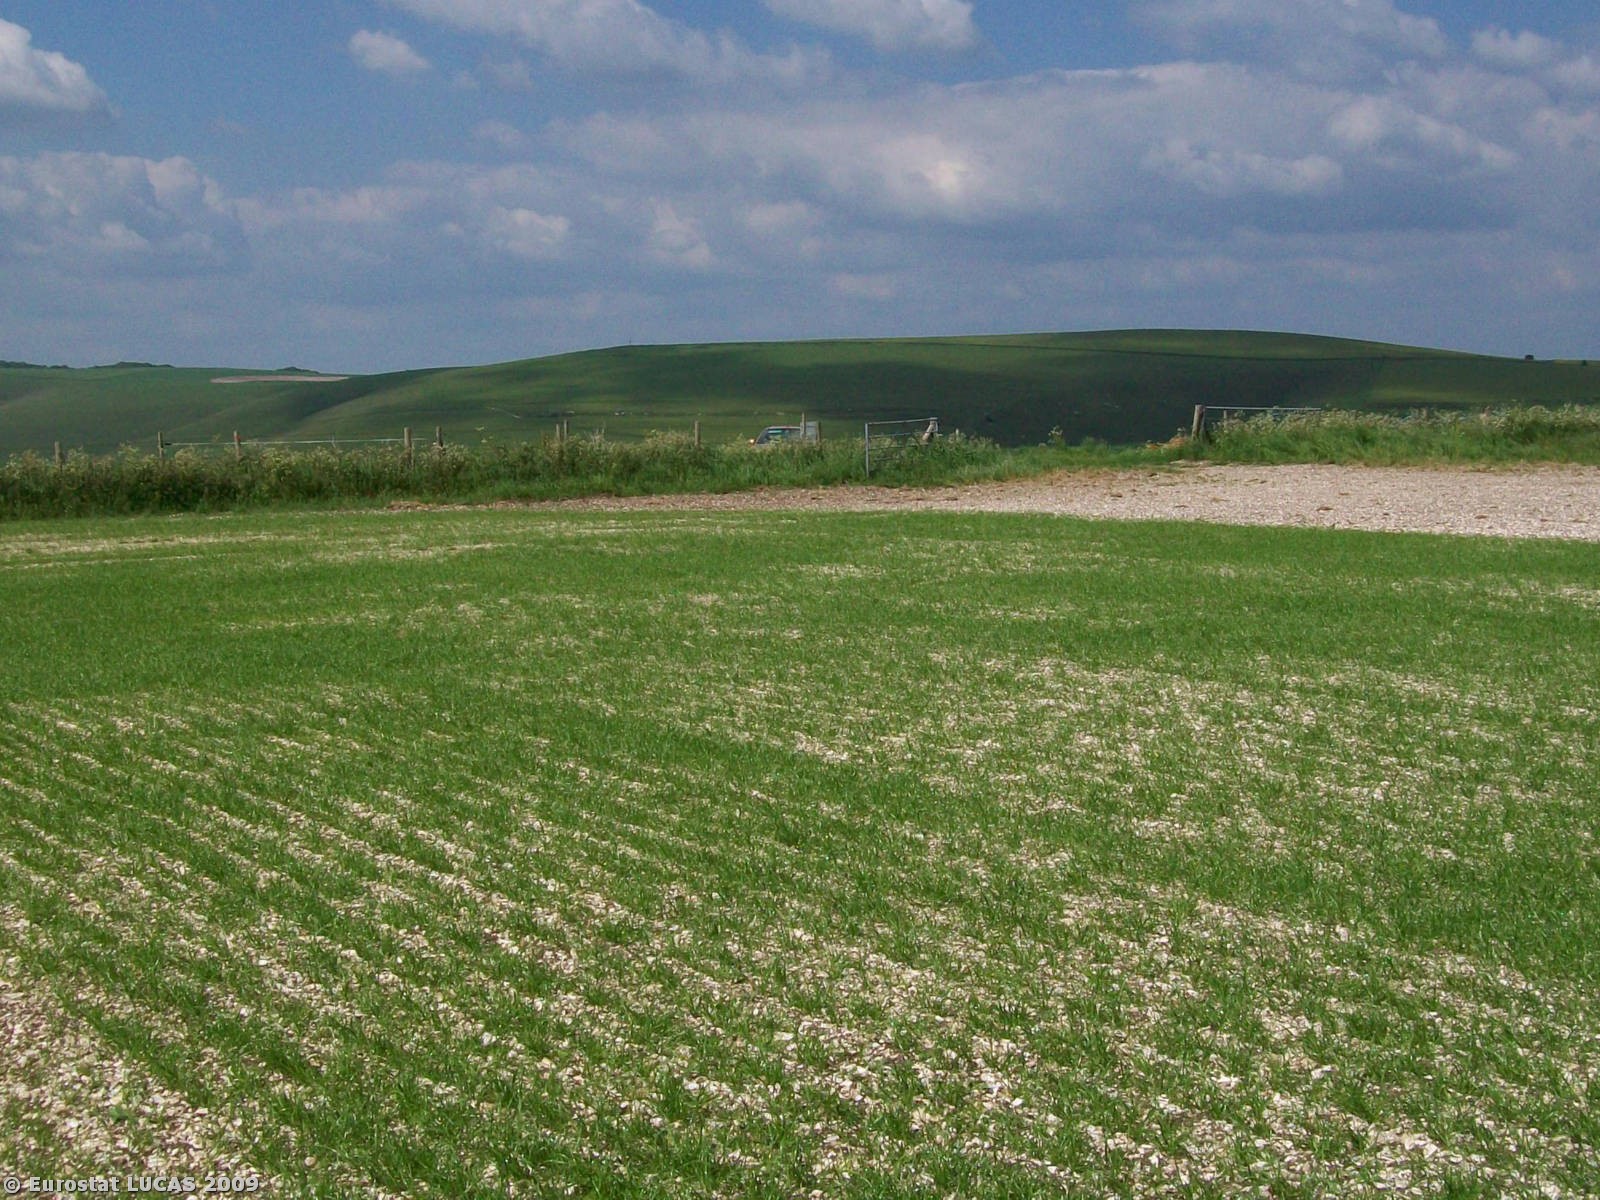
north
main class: Cropland
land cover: Barley
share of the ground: 50 - 75 %
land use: Agriculture (excluding fallow land and kitchen gardens)
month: May
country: GB
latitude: 51.1246
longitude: -2.2210
